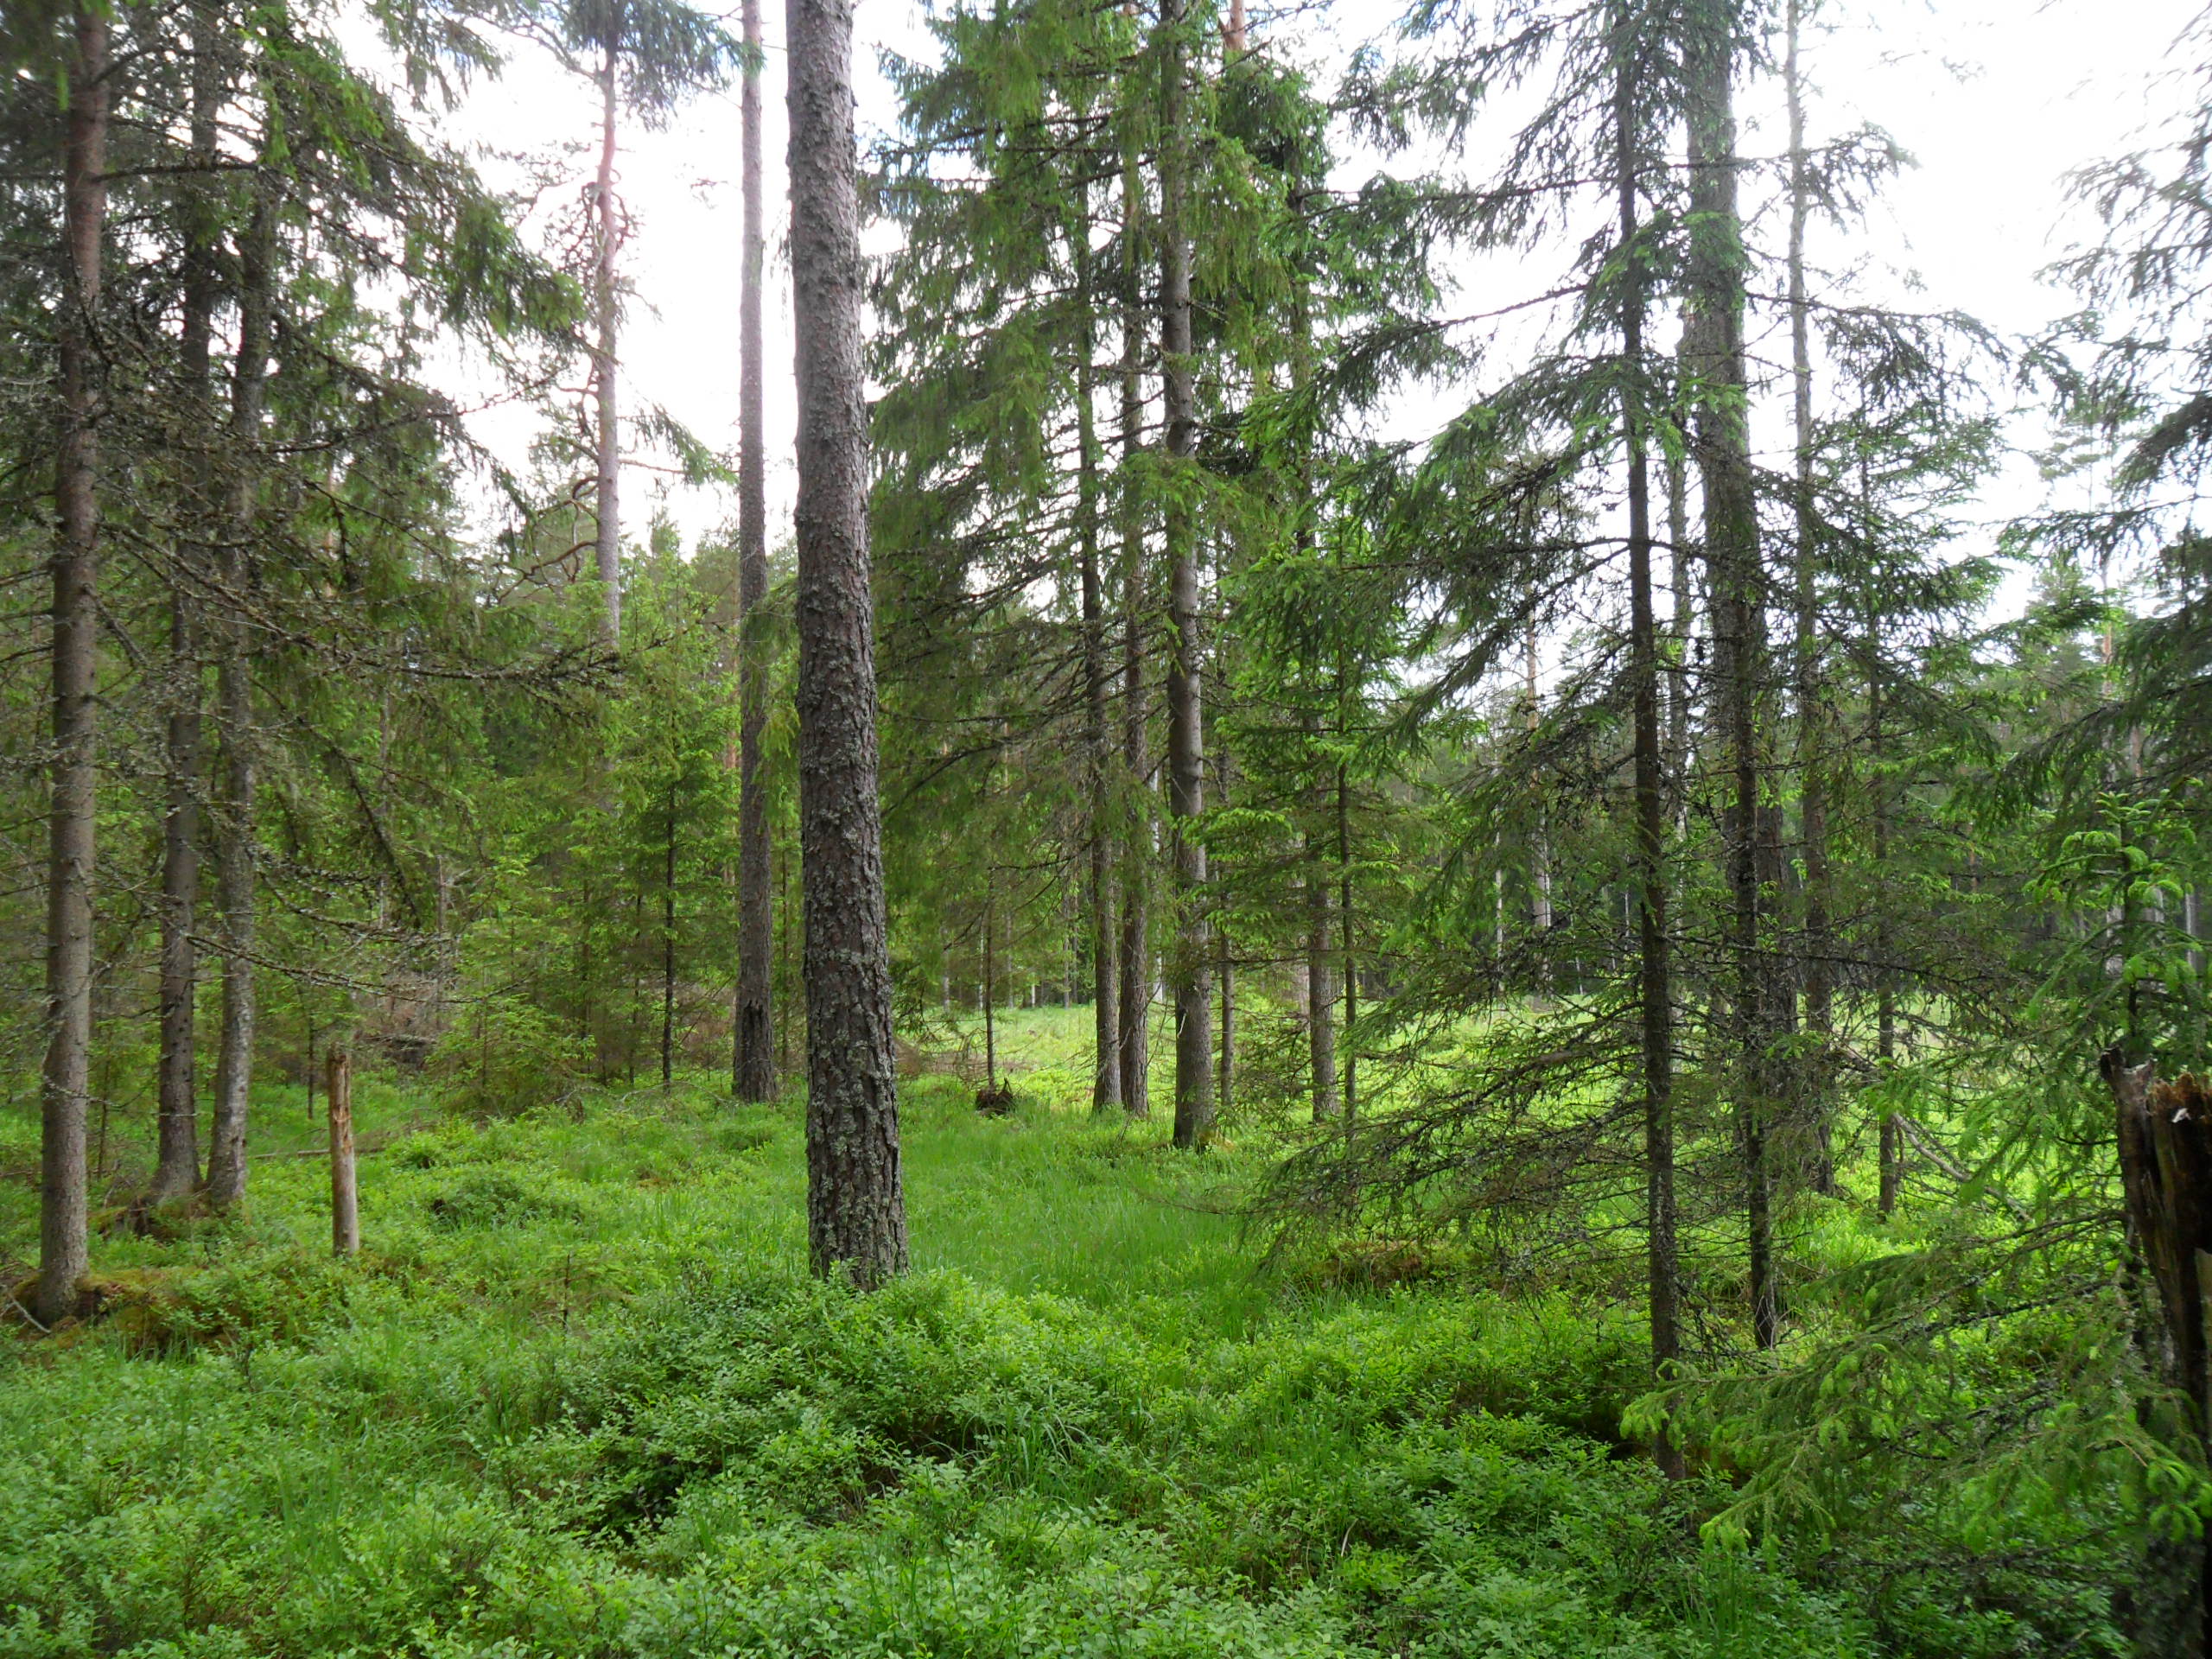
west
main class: Woodland
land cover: Other coniferous woodland
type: hemiboreal forest and nemoral coniferous forest and mixed broadleaved-coniferous forest
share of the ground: 50 - 75 %
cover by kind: coniferous forest trees 65 %, herbaceous plants 30 %, lichens and mosses 5 %
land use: Forestry
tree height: > 5 m
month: June
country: LV
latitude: 57.4168
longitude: 22.0842
